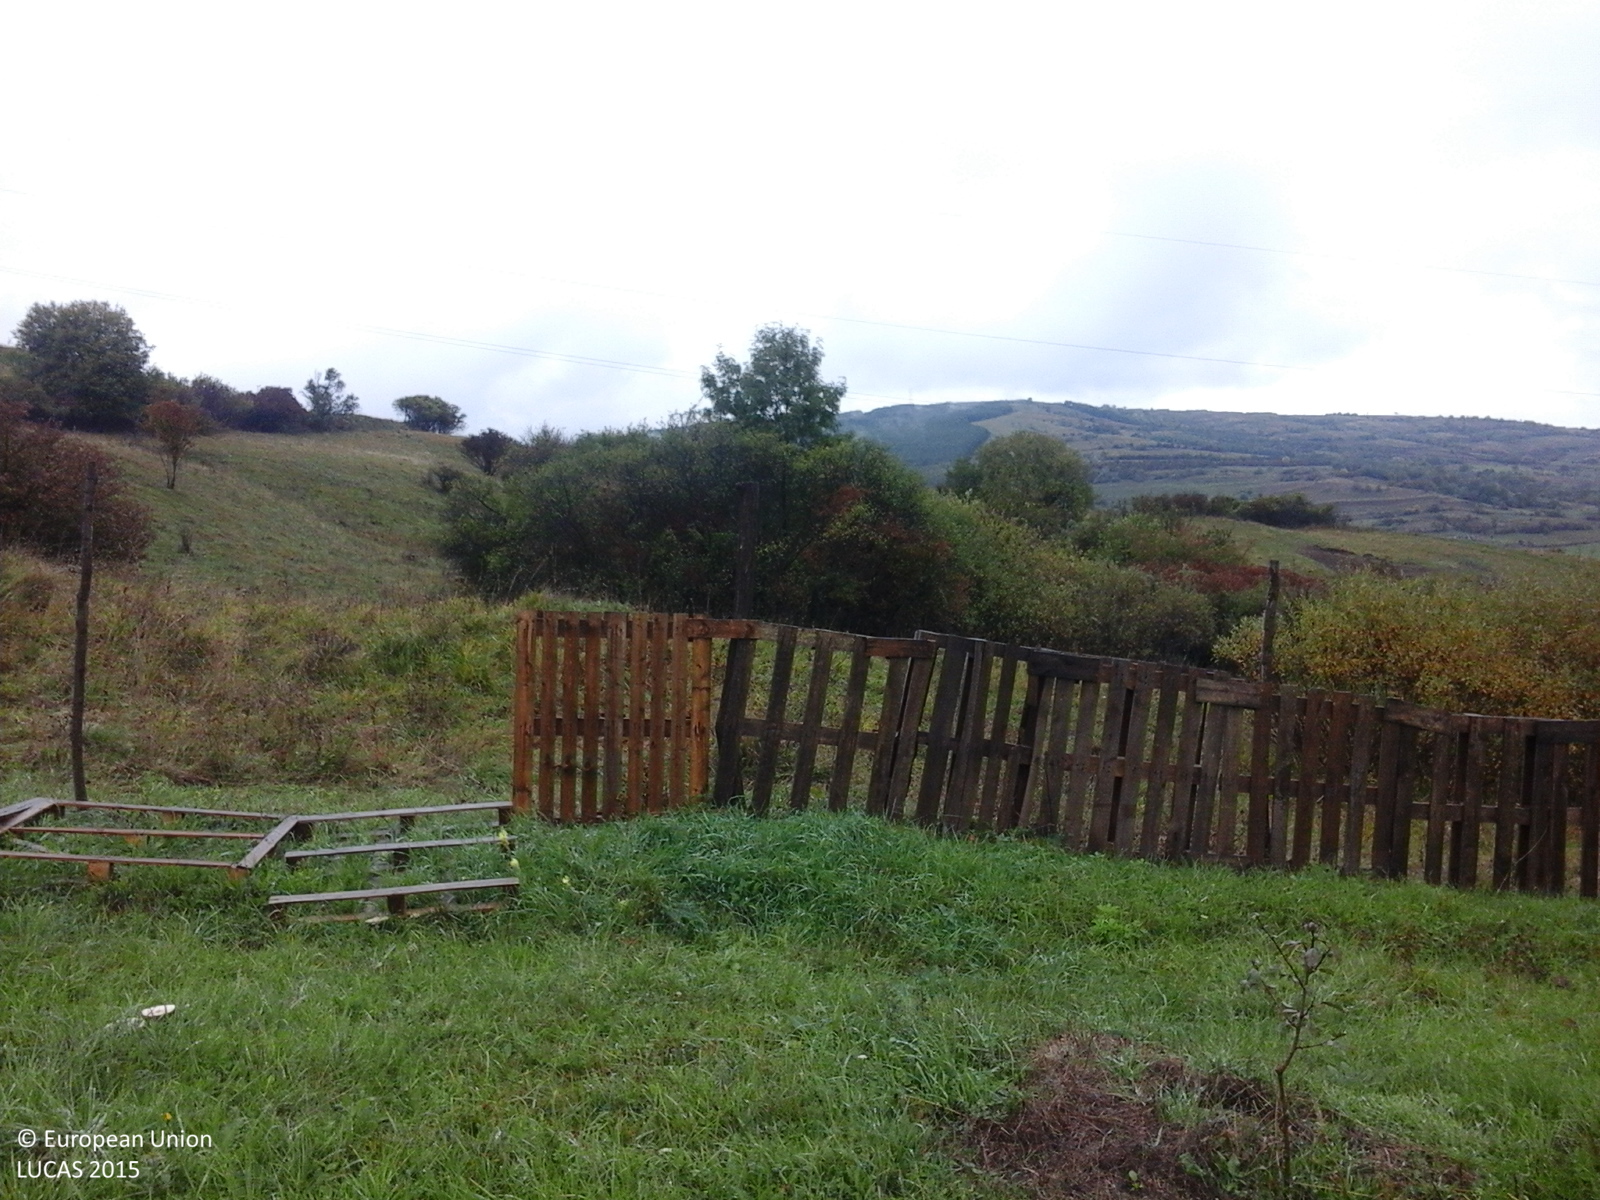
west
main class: Cropland
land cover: Apple fruit
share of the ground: 10 - 25 %
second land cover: Grassland without tree/shrub cover
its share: > 75 %
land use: Agriculture (excluding fallow land and kitchen gardens)
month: October
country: RO
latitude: 45.9881
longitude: 24.1609
